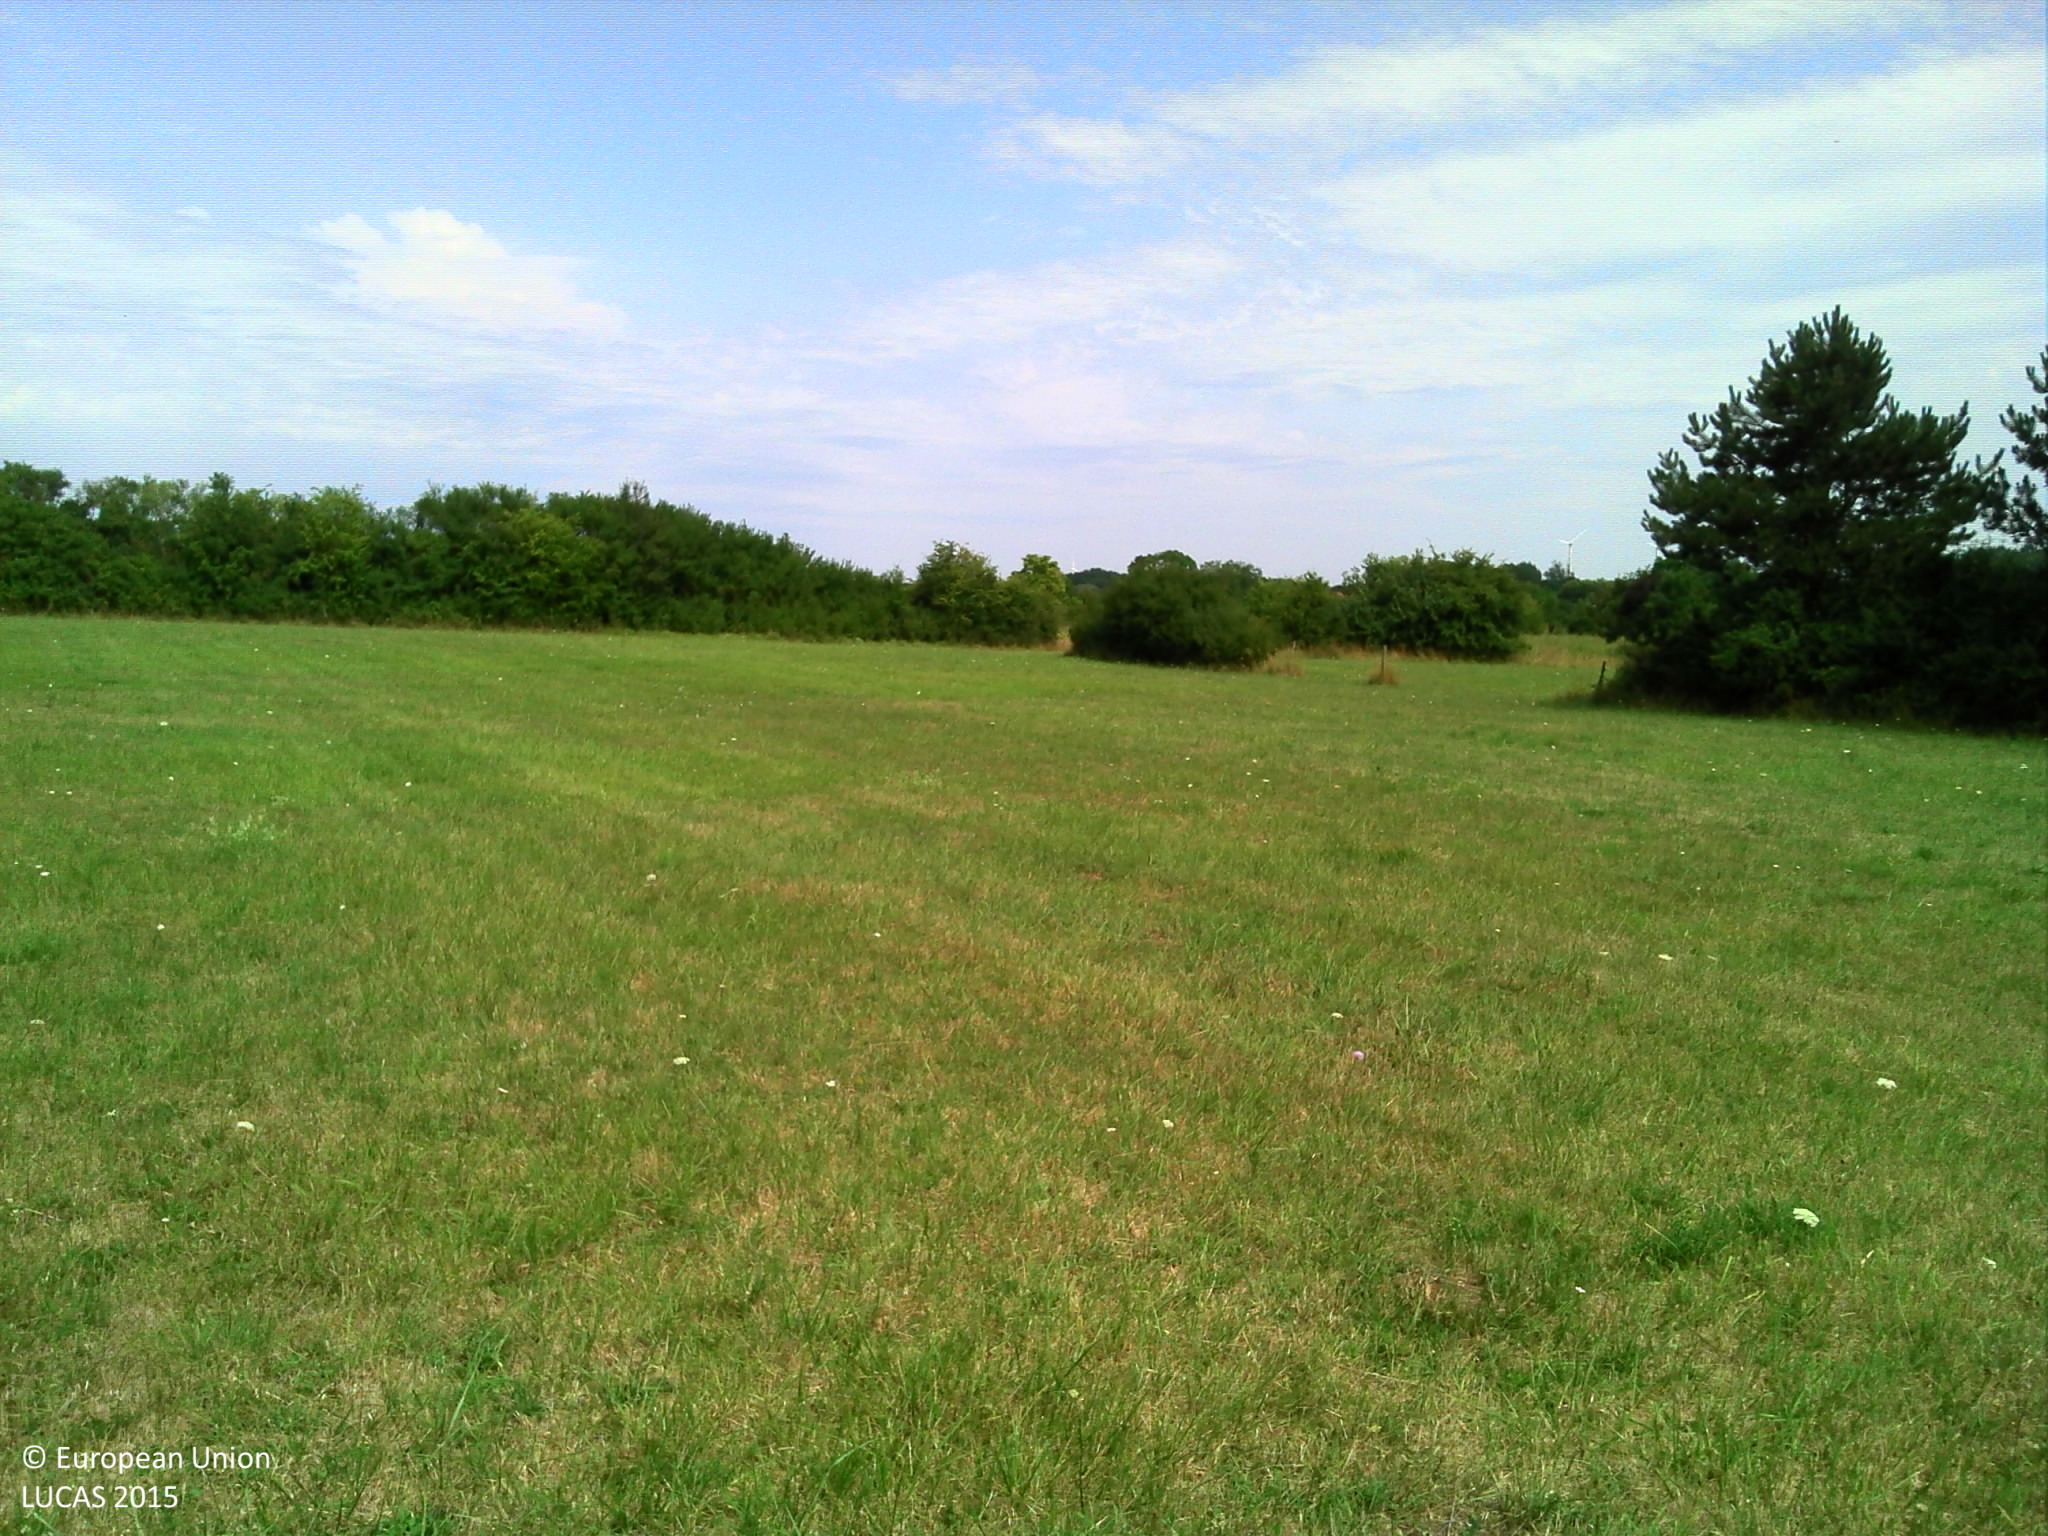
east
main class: Grassland
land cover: Grassland without tree/shrub cover
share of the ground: > 75 %
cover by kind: herbaceous plants 100 %
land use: Agriculture (excluding fallow land and kitchen gardens)
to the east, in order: Grassland without tree/shrub cover; Fences; Broadleaved woodland; Grassland without tree/shrub cover; Fences; Managed hedges; Grassland without tree/shrub cover; Fences; Managed hedges
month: July
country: FR
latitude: 49.0726
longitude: -0.2037
